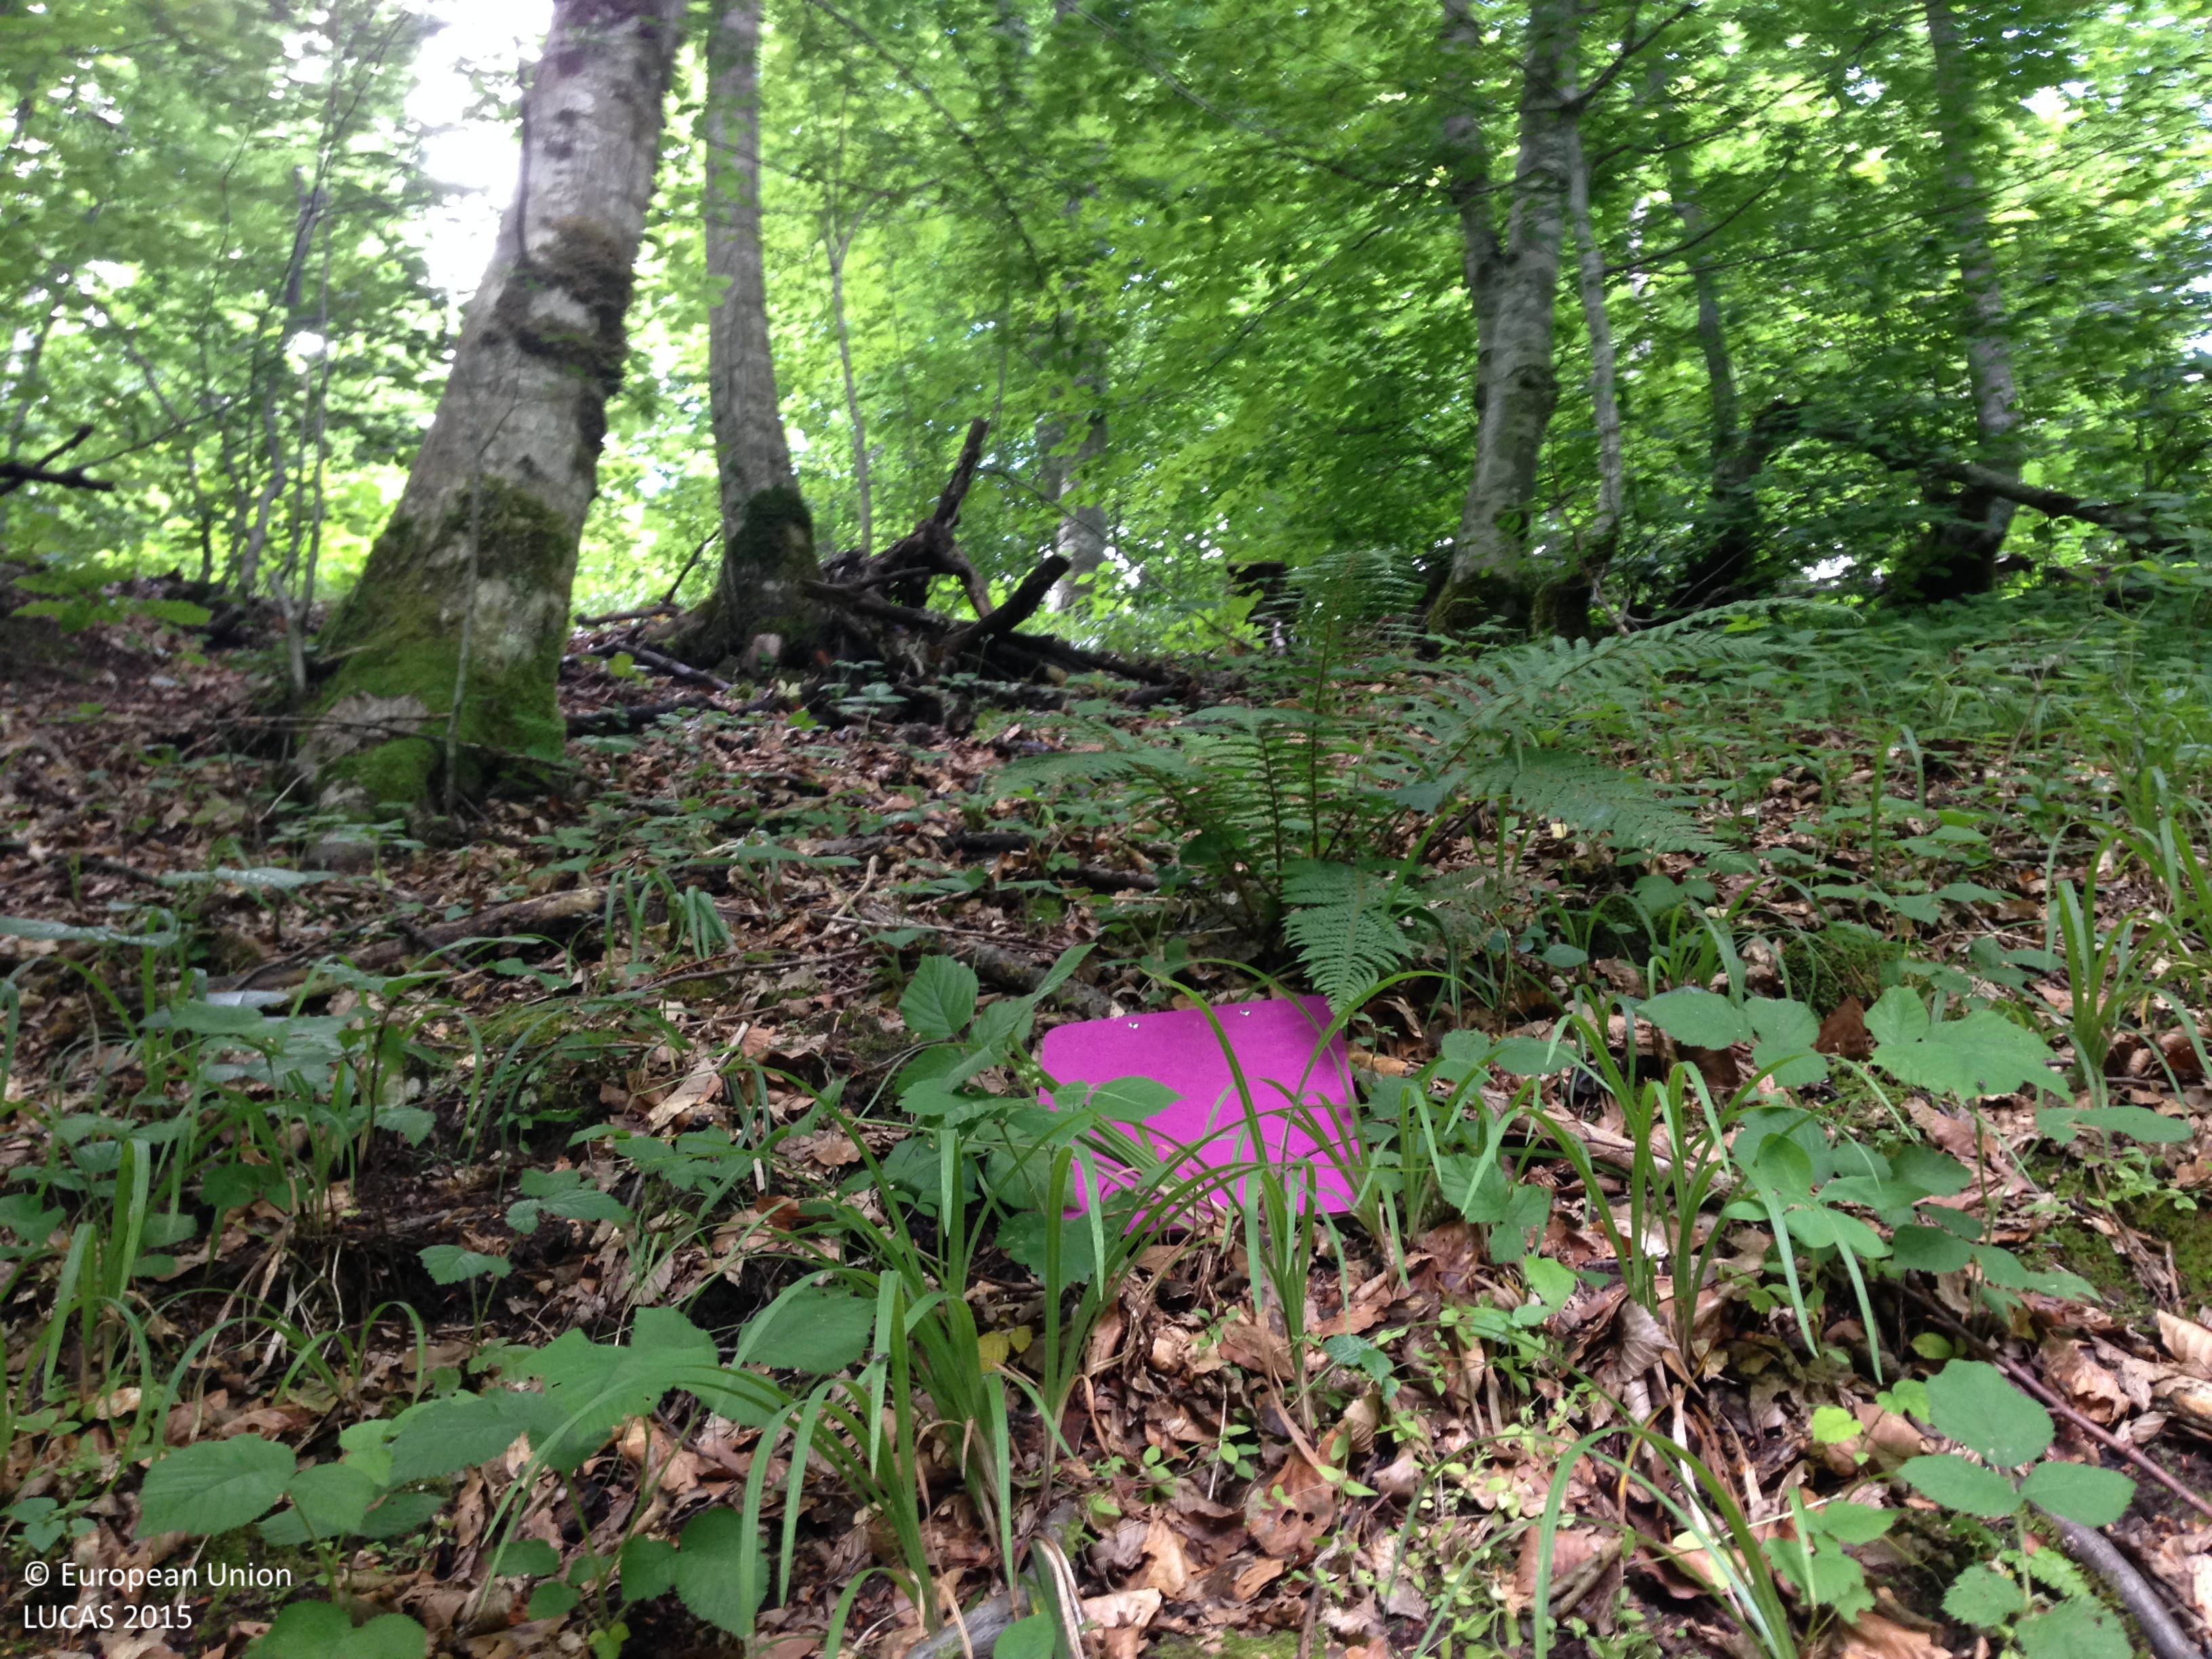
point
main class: Woodland
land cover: Broadleaved woodland
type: beech forest
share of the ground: > 75 %
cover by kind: broadleaved forest trees 60 %, herbaceous plants 15 %, shrubs 10 %, consolidated bare surface 10 %, lichens and mosses 5 %
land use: Forestry
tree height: > 5 m
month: June
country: HR
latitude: 44.6867
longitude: 15.9372
